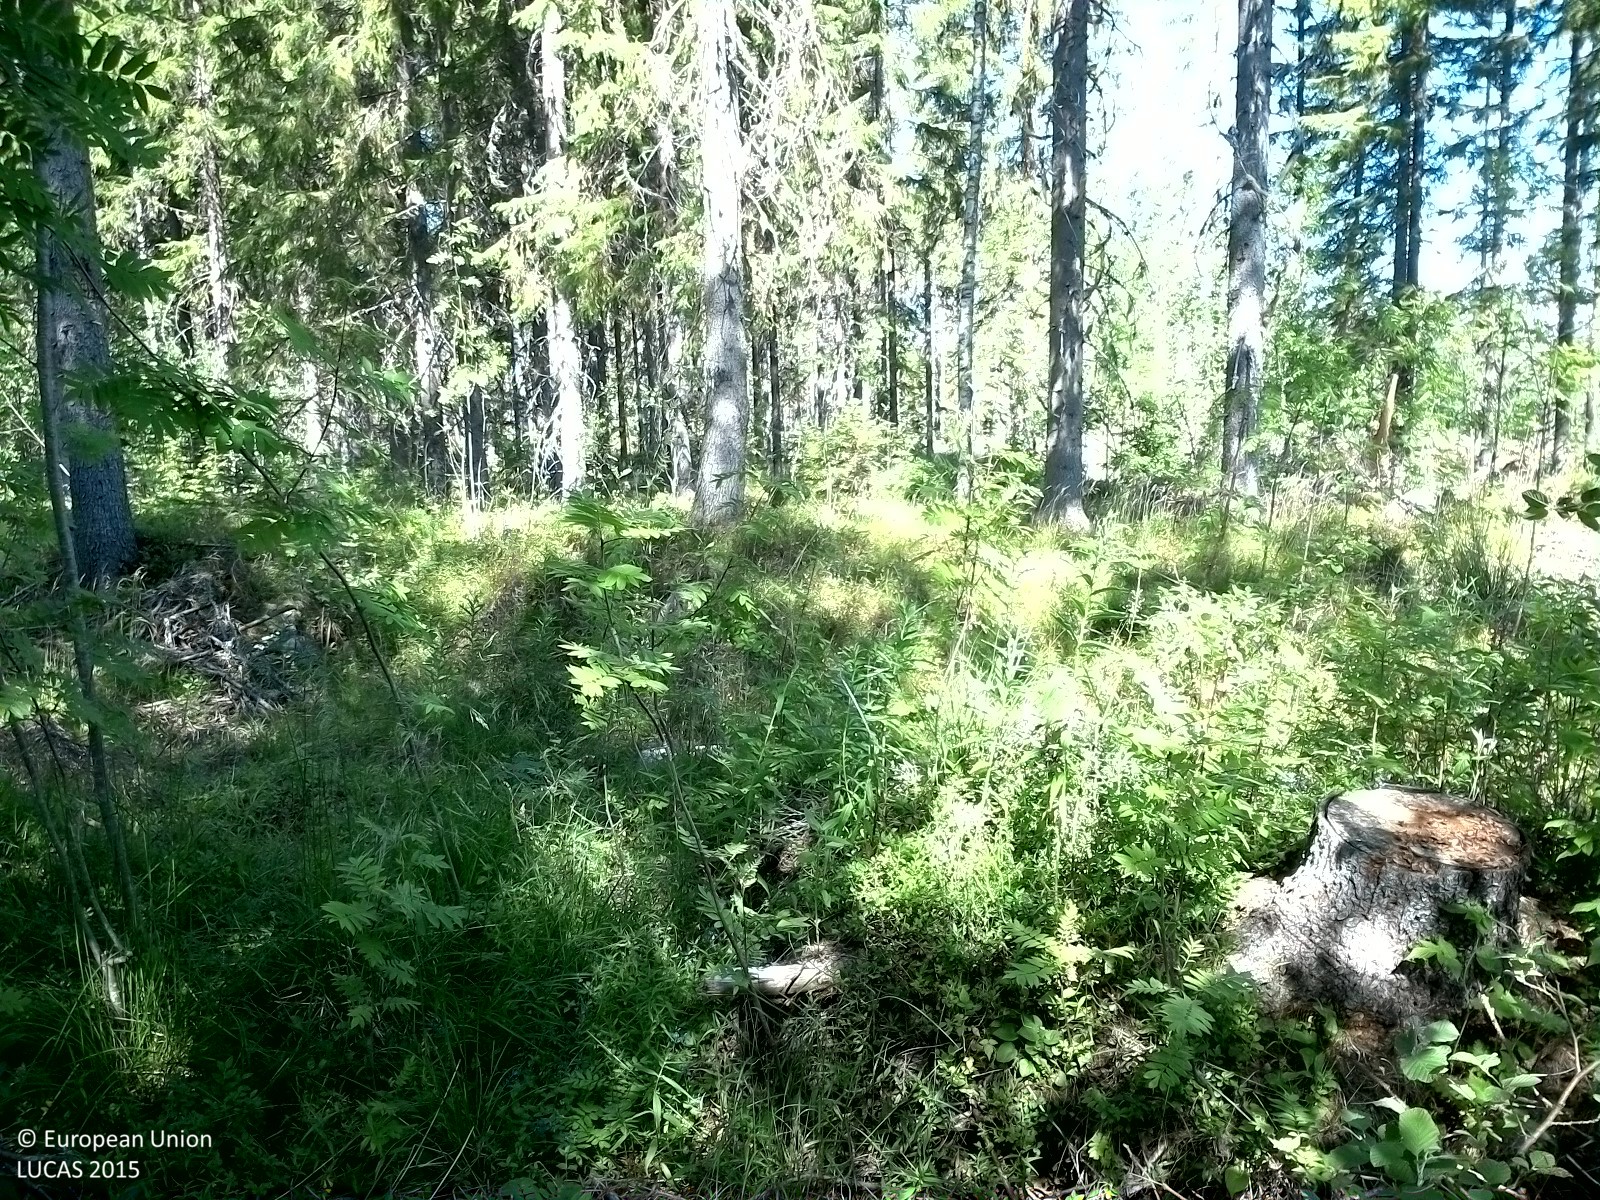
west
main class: Woodland
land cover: Spruce dominated mixed woodland
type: boreal forest
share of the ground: > 75 %
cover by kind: broadleaved forest trees 50 %, coniferous forest trees 35 %, herbaceous plants 15 %
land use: Forestry
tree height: > 5 m
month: July
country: SE
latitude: 62.2697
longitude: 16.9736
